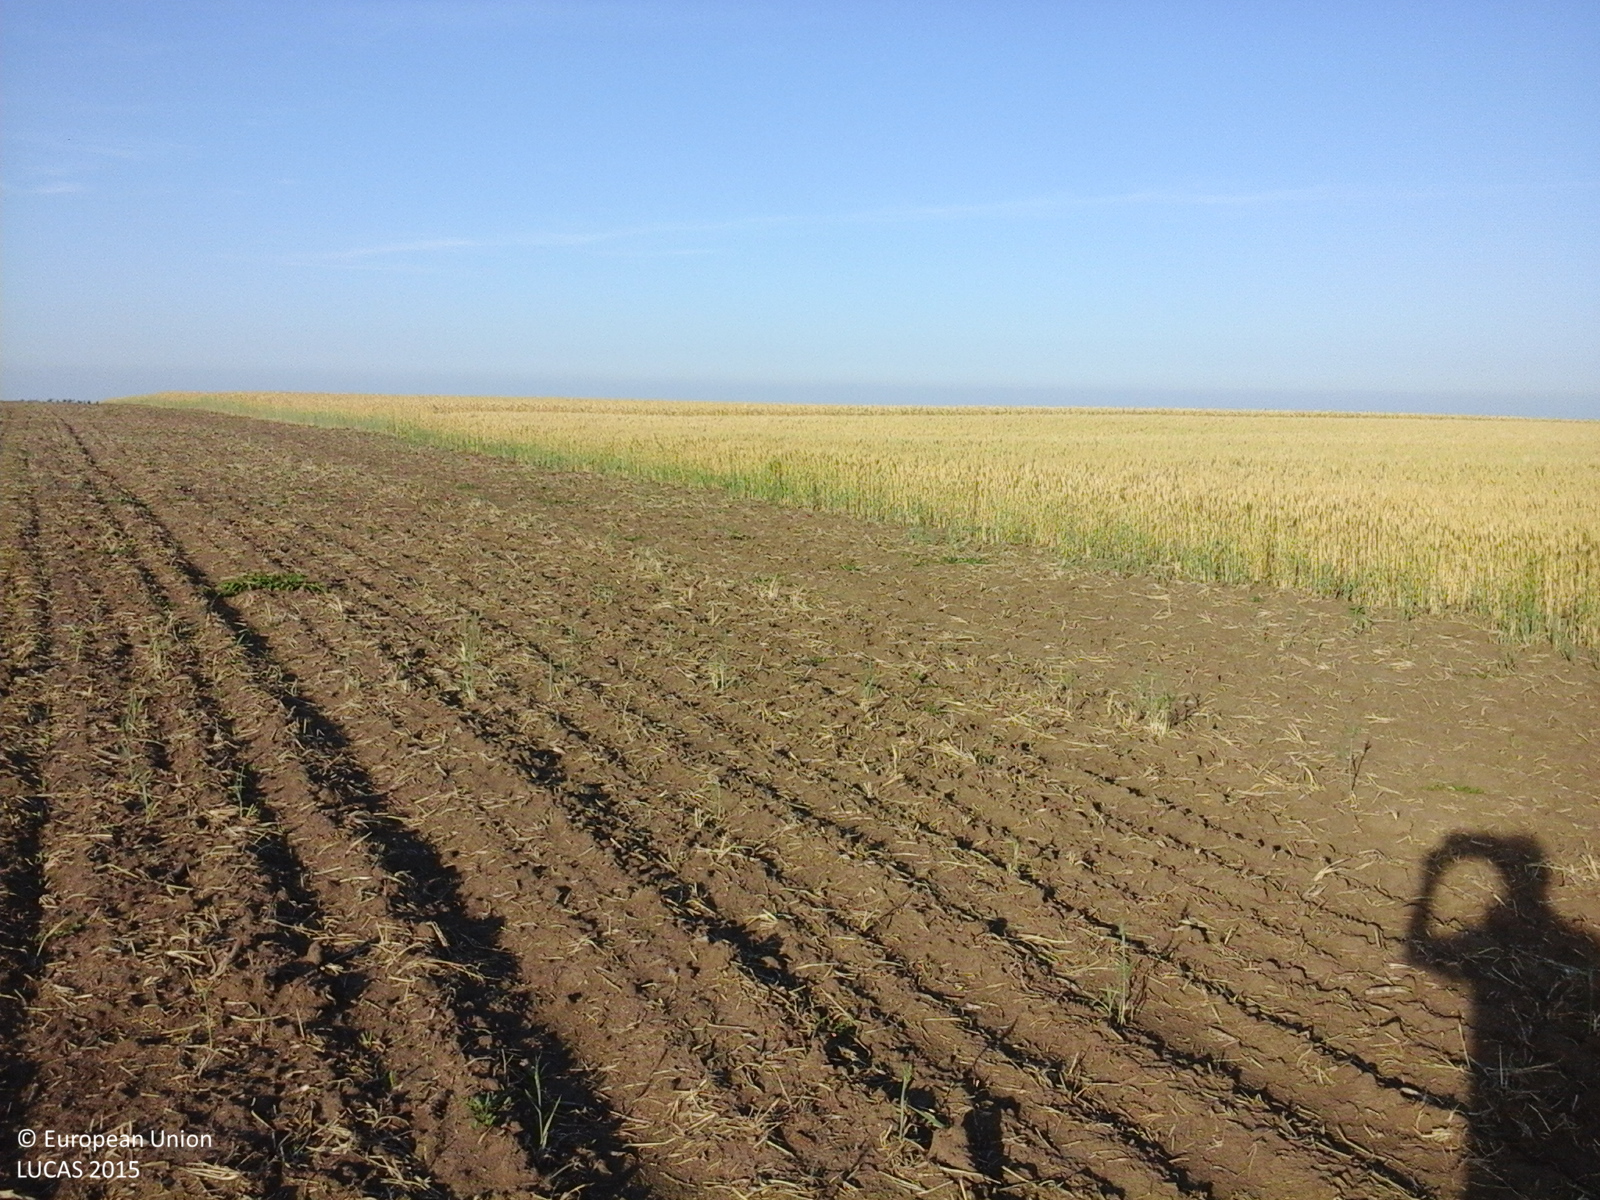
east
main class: Cropland
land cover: Common wheat
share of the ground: < 10 %
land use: Agriculture (excluding fallow land and kitchen gardens)
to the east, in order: Common wheat; Tracks; Common wheat
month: June
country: RO
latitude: 47.0961
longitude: 26.9765
